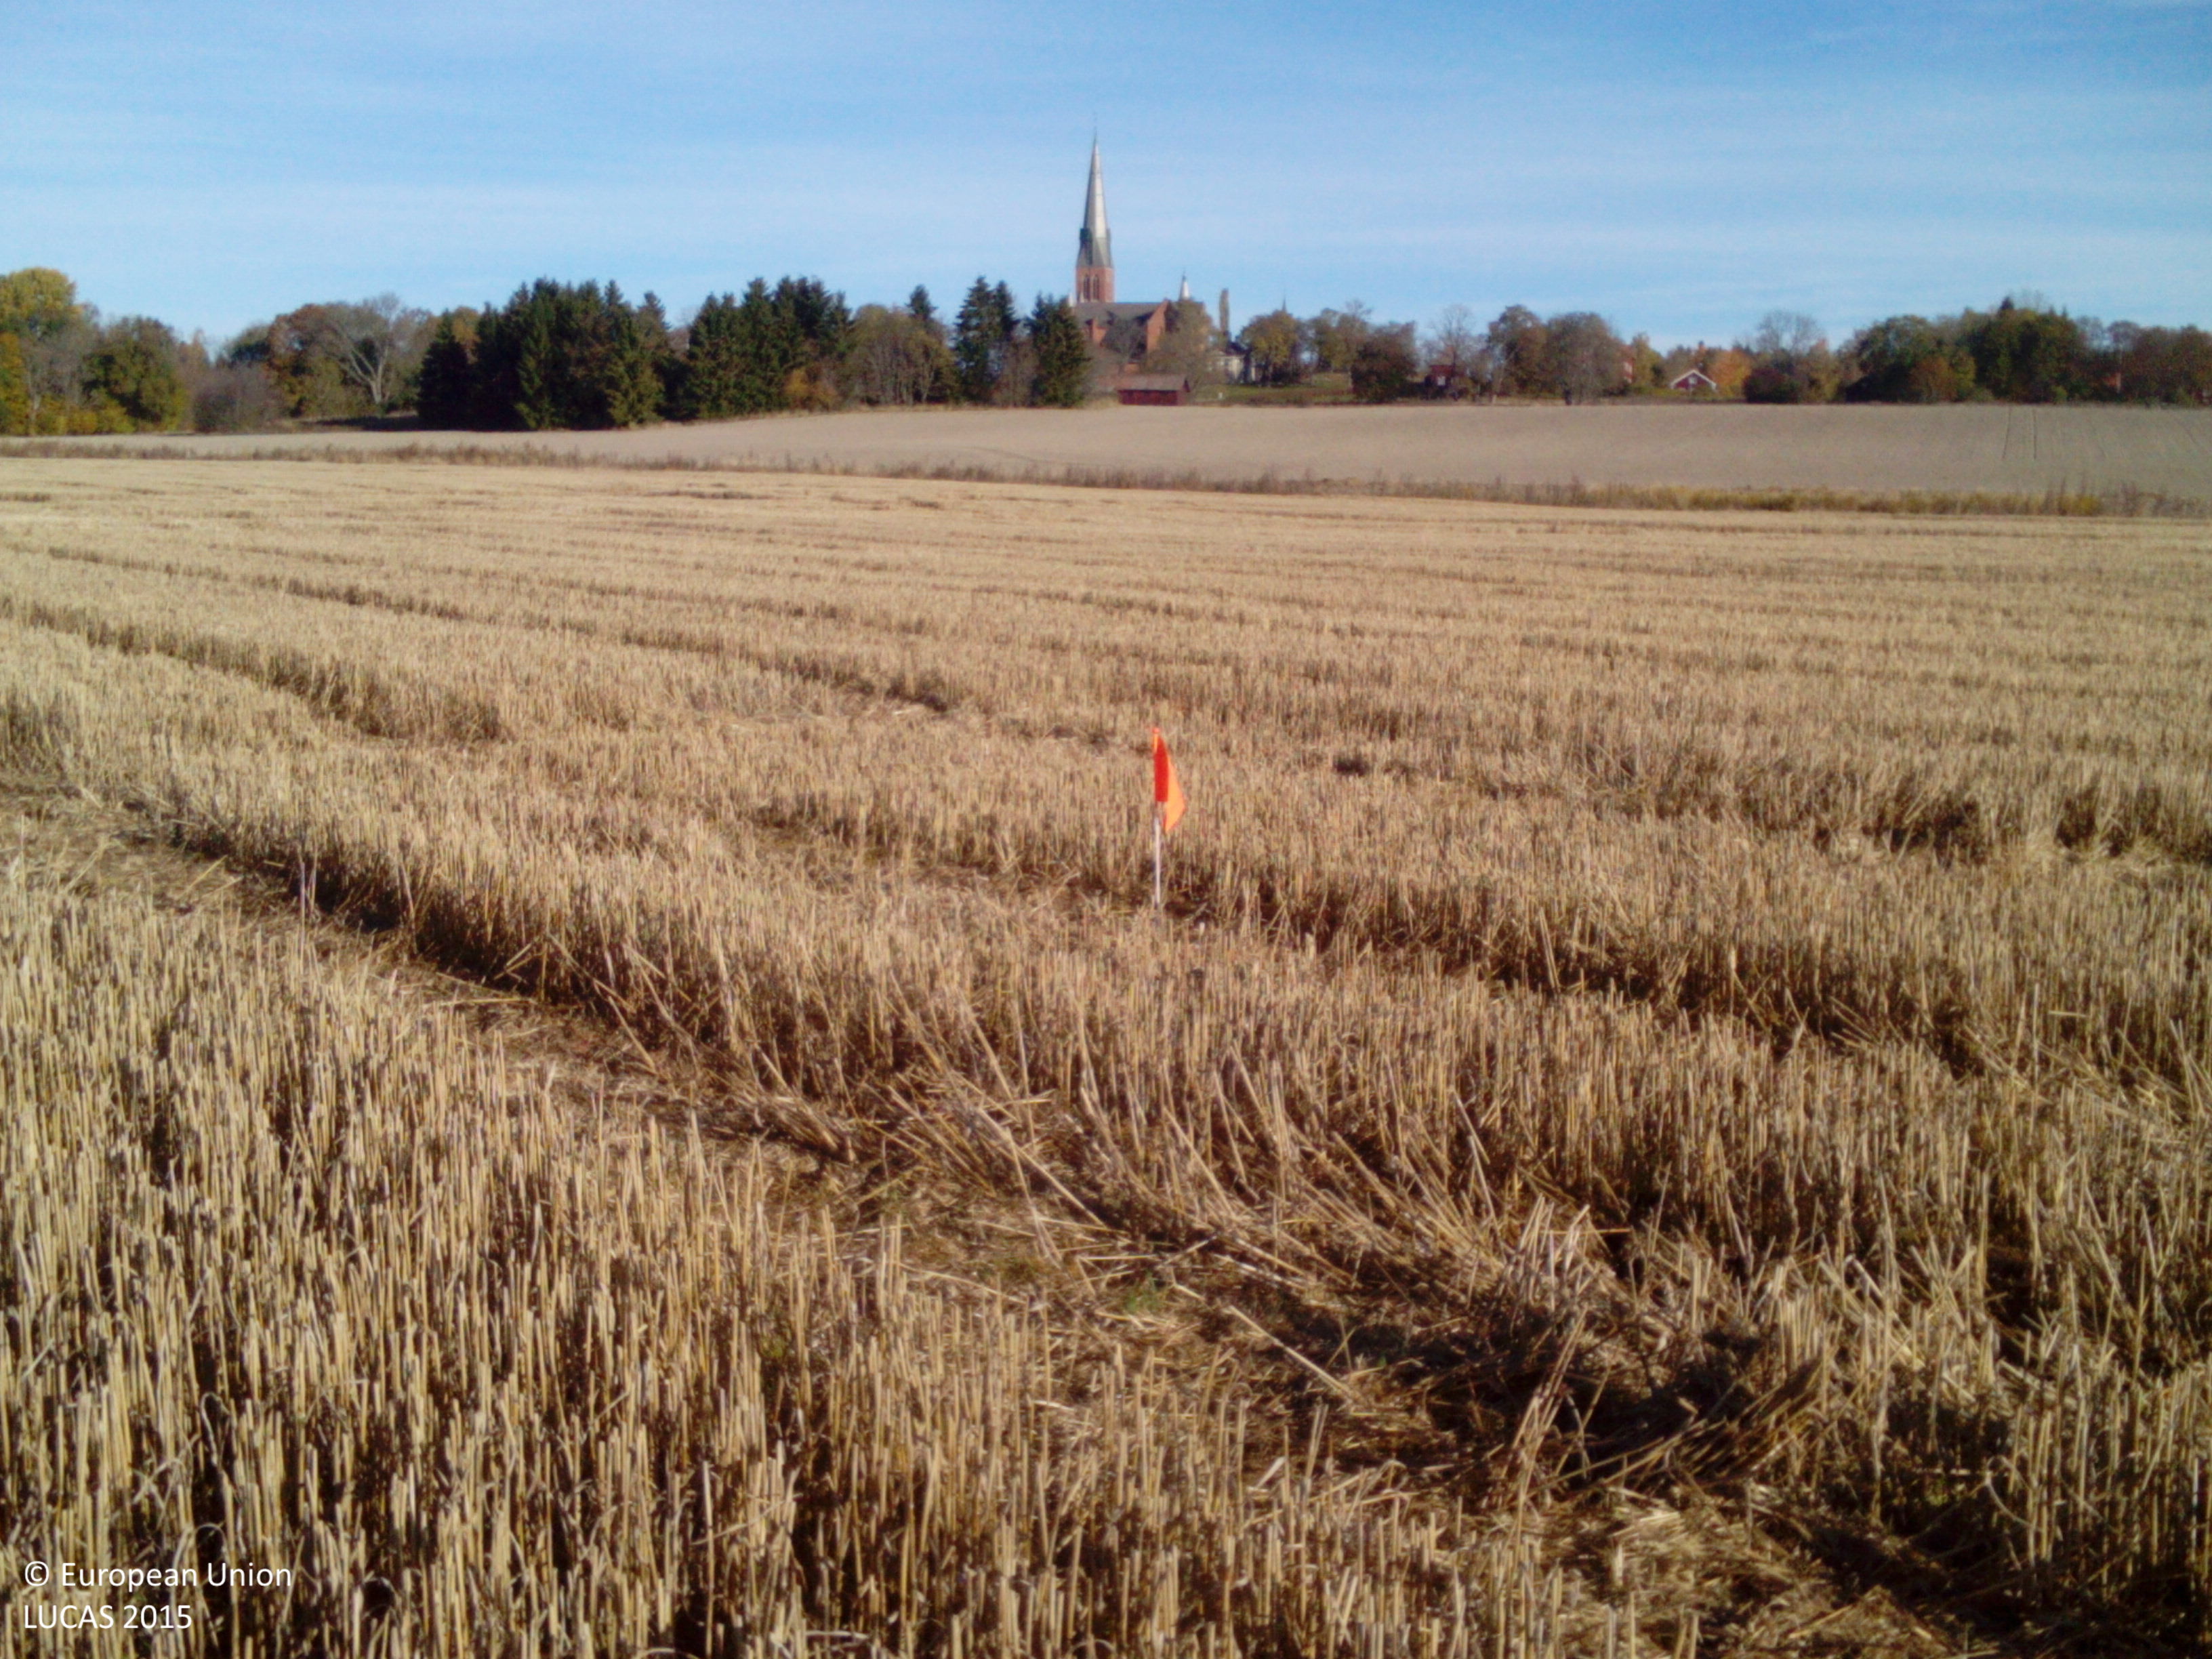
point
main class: Cropland
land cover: Common wheat
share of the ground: > 75 %
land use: Agriculture (excluding fallow land and kitchen gardens)
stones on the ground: < 10 %
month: October
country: SE
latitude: 59.0620
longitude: 16.3590
